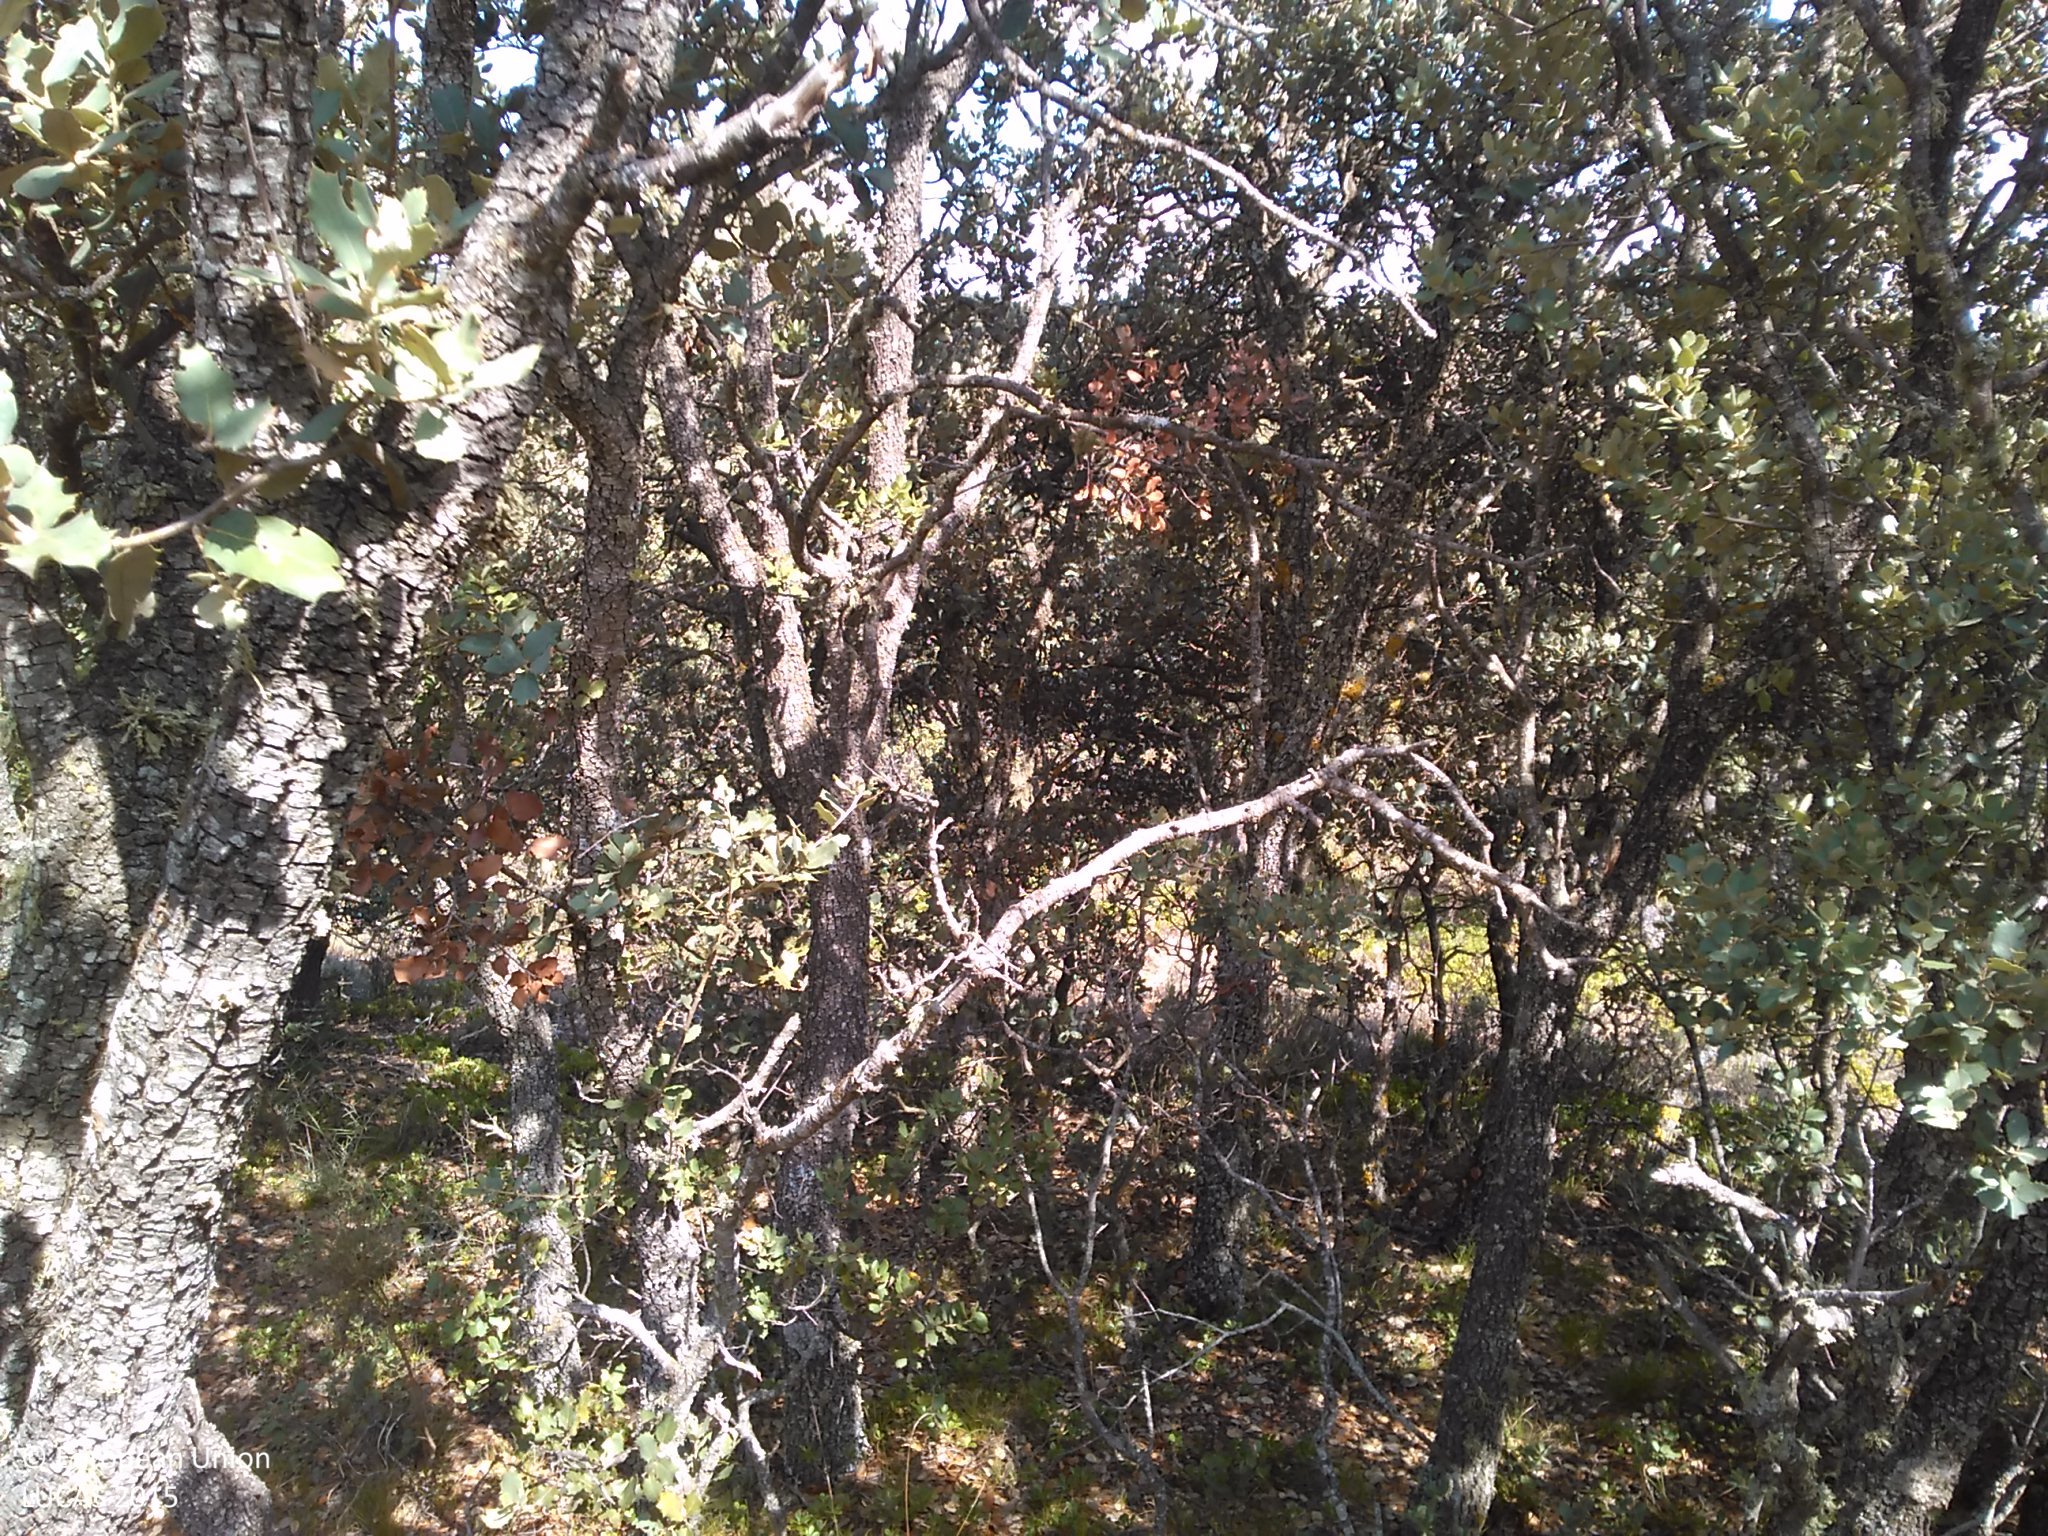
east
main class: Woodland
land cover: Broadleaved woodland
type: thermophilous deciduous forest
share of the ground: 50 - 75 %
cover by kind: broadleaved forest trees 60 %, unconsolidated bare surface 15 %, shrubs 10 %, herbaceous plants 10 %, lichens and mosses 5 %
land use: Semi-natural and natural areas not in use
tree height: < 5 m
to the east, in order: Broadleaved woodland; Paved roads, cycling and walking lanes; Spontaneously vegetated surfaces; Barley; Rivers and streams; Grassland without tree/shrub cover; Barley; Grass margins; Tracks; Grass margins; Barley
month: July
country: ES
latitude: 41.5307
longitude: -2.1975
